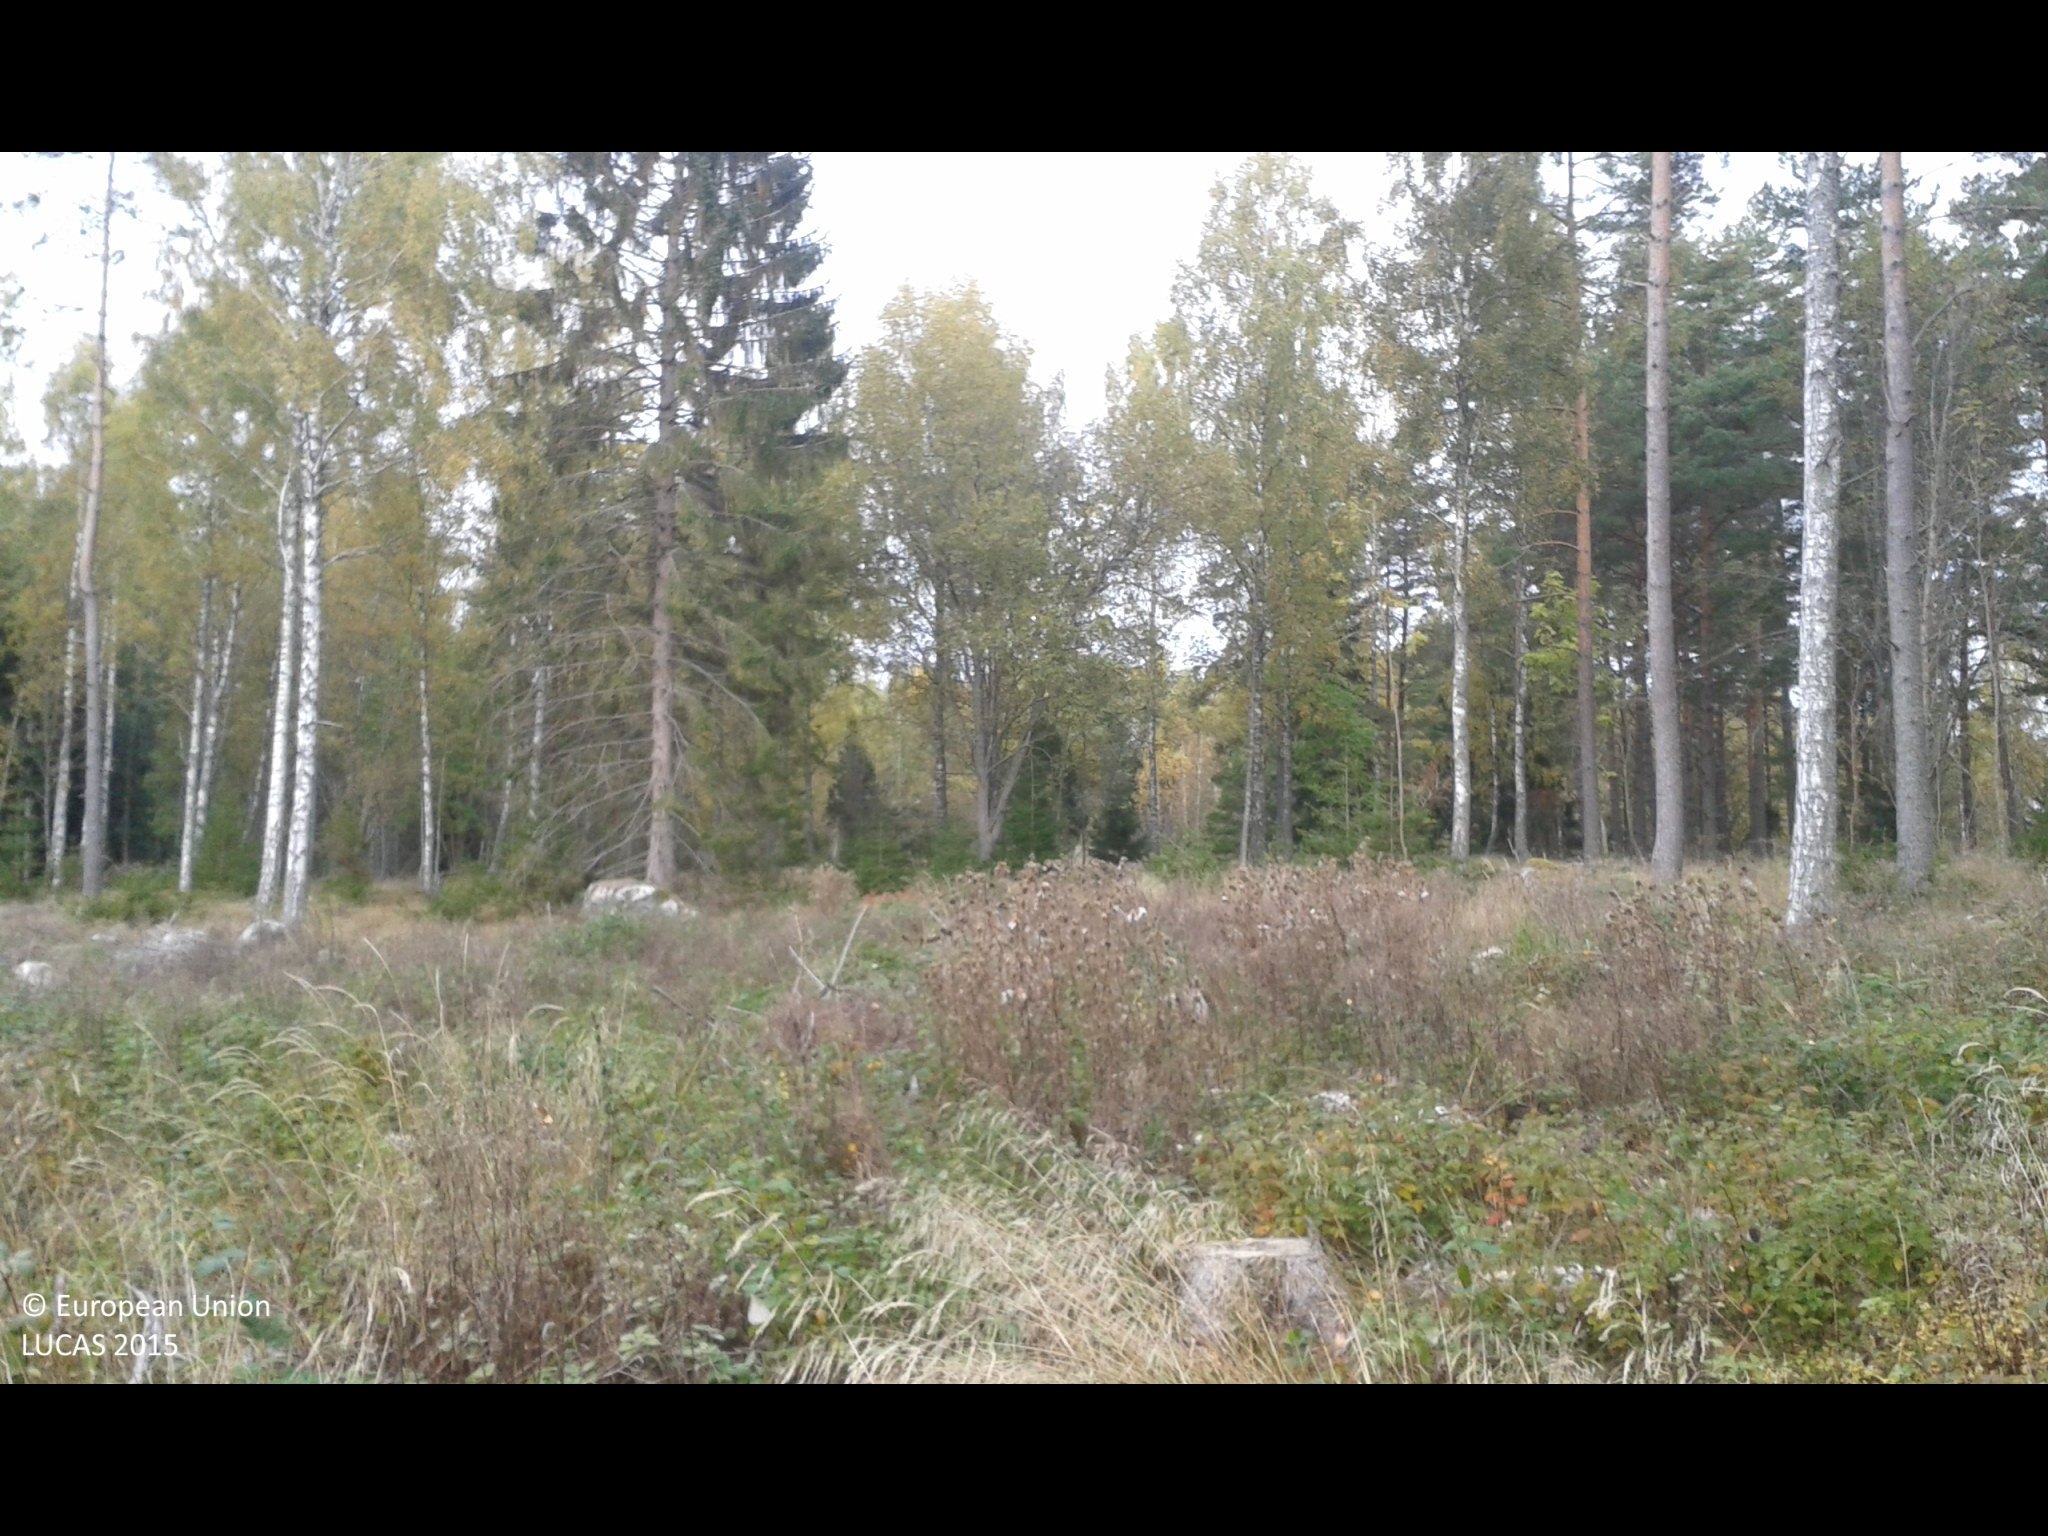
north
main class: Grassland
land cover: Spontaneously vegetated surfaces
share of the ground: > 75 %
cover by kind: herbaceous plants 100 %
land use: Forestry
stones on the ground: 10 - 25 %
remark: Clear cut
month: October
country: SE
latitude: 58.7614
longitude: 17.3106
